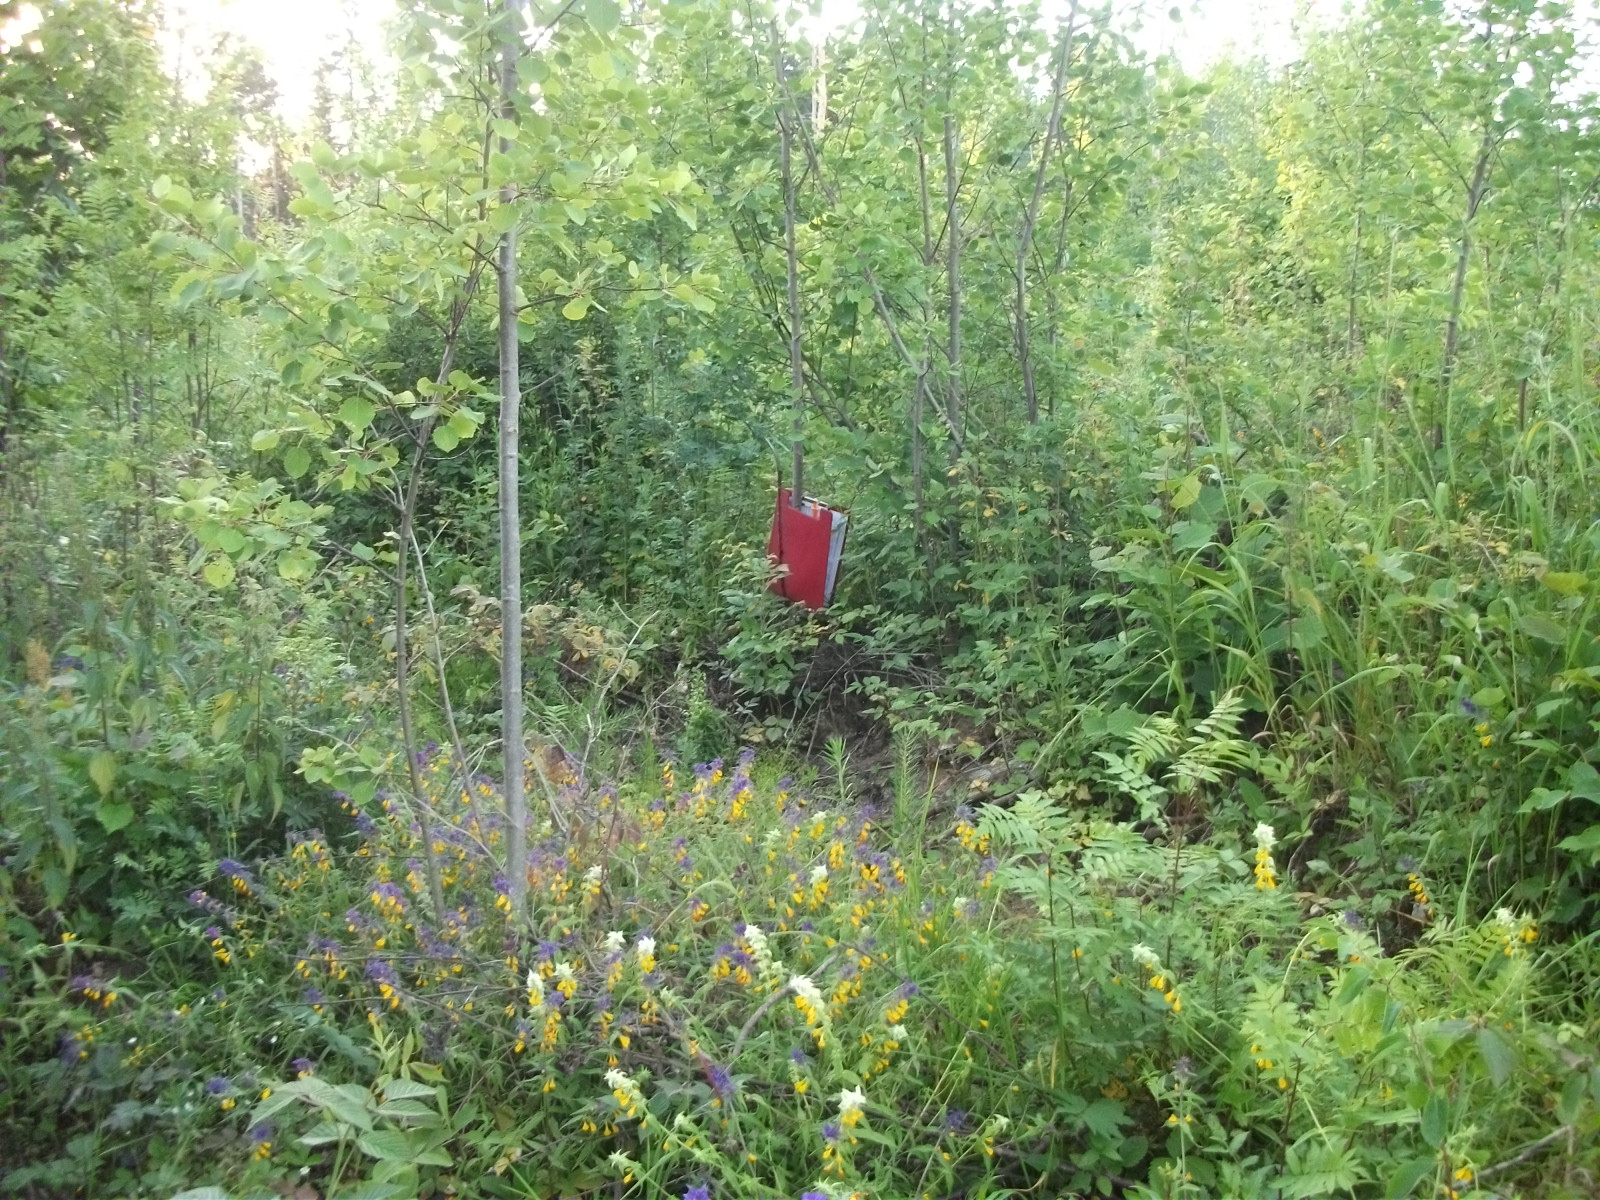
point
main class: Woodland
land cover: Broadleaved woodland
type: non-riverine alder, birch or aspen forest
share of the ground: > 75 %
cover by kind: broadleaved forest trees 80 %, shrubs 10 %, herbaceous plants 10 %
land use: Forestry
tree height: < 5 m
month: July
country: LV
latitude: 56.8377
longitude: 26.2179
